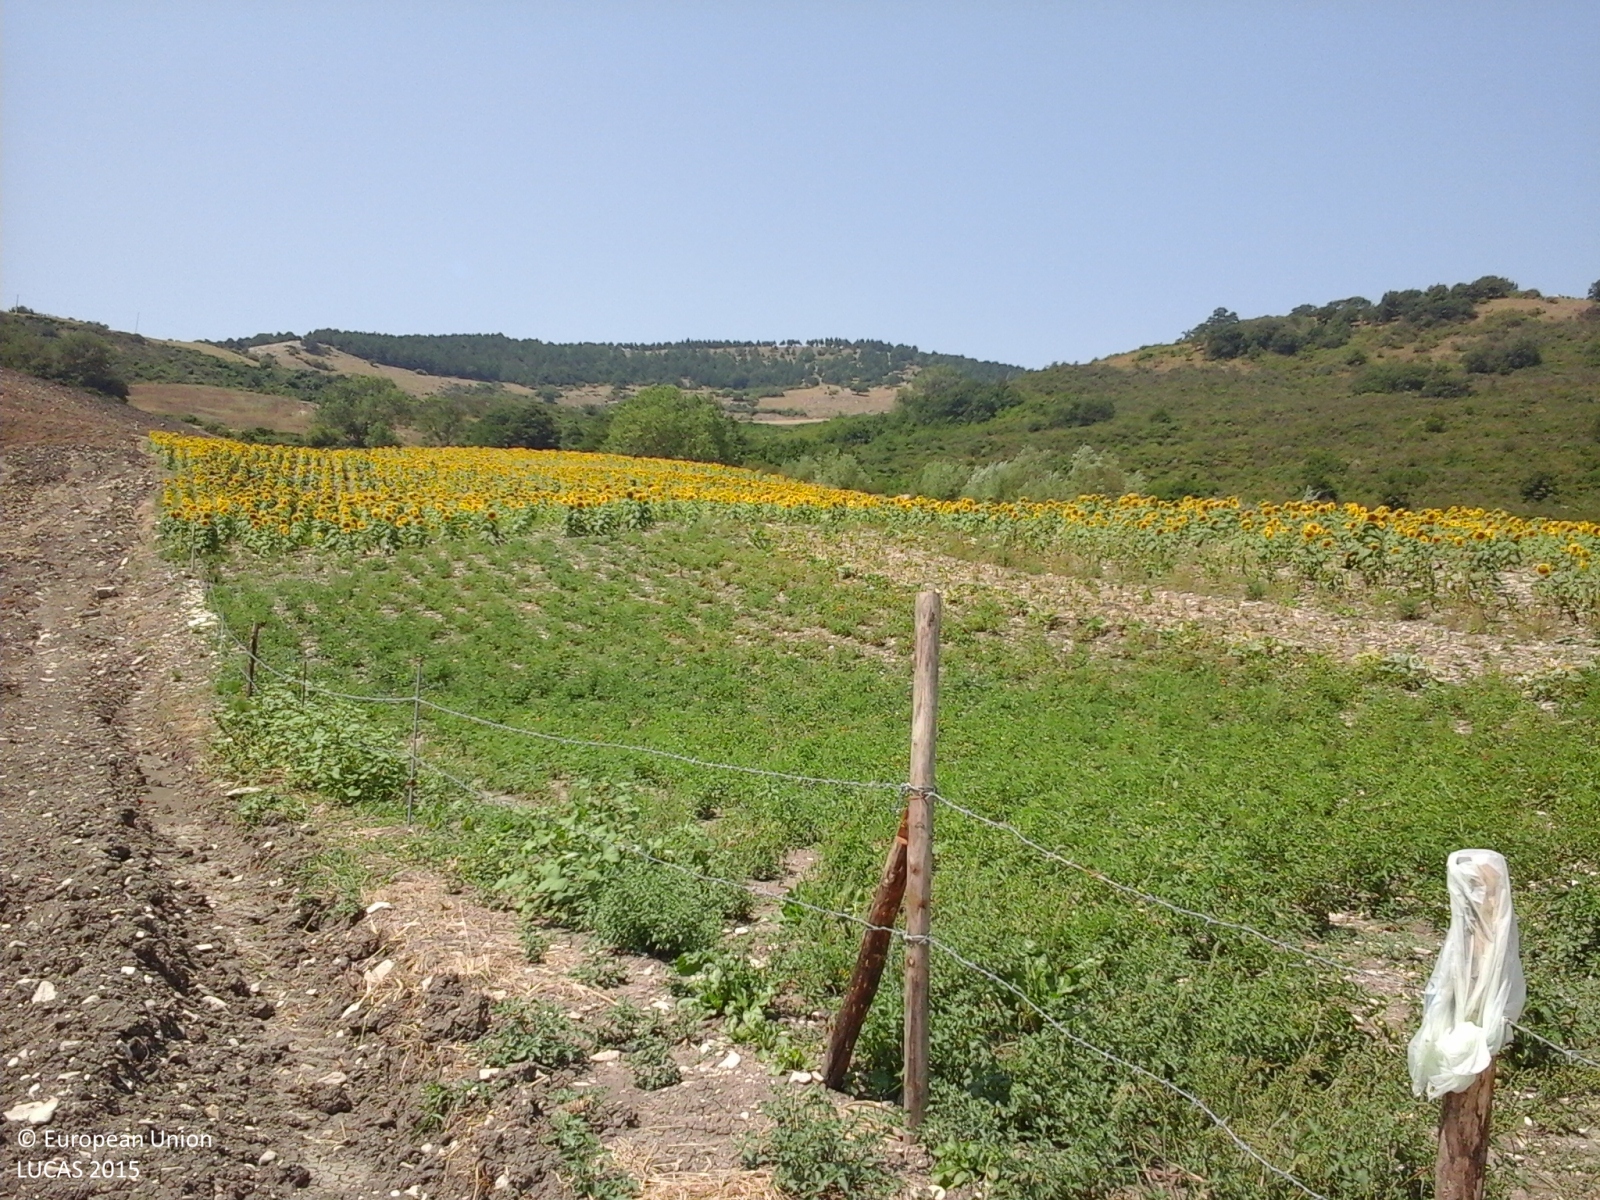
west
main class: Shrubland
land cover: Shrubland with sparse tree cover
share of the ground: > 75 %
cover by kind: shrubs 95 %, broadleaved forest trees 5 %
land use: Abandoned areas
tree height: > 5 m
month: August
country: IT
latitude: 41.3627
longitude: 15.1821
